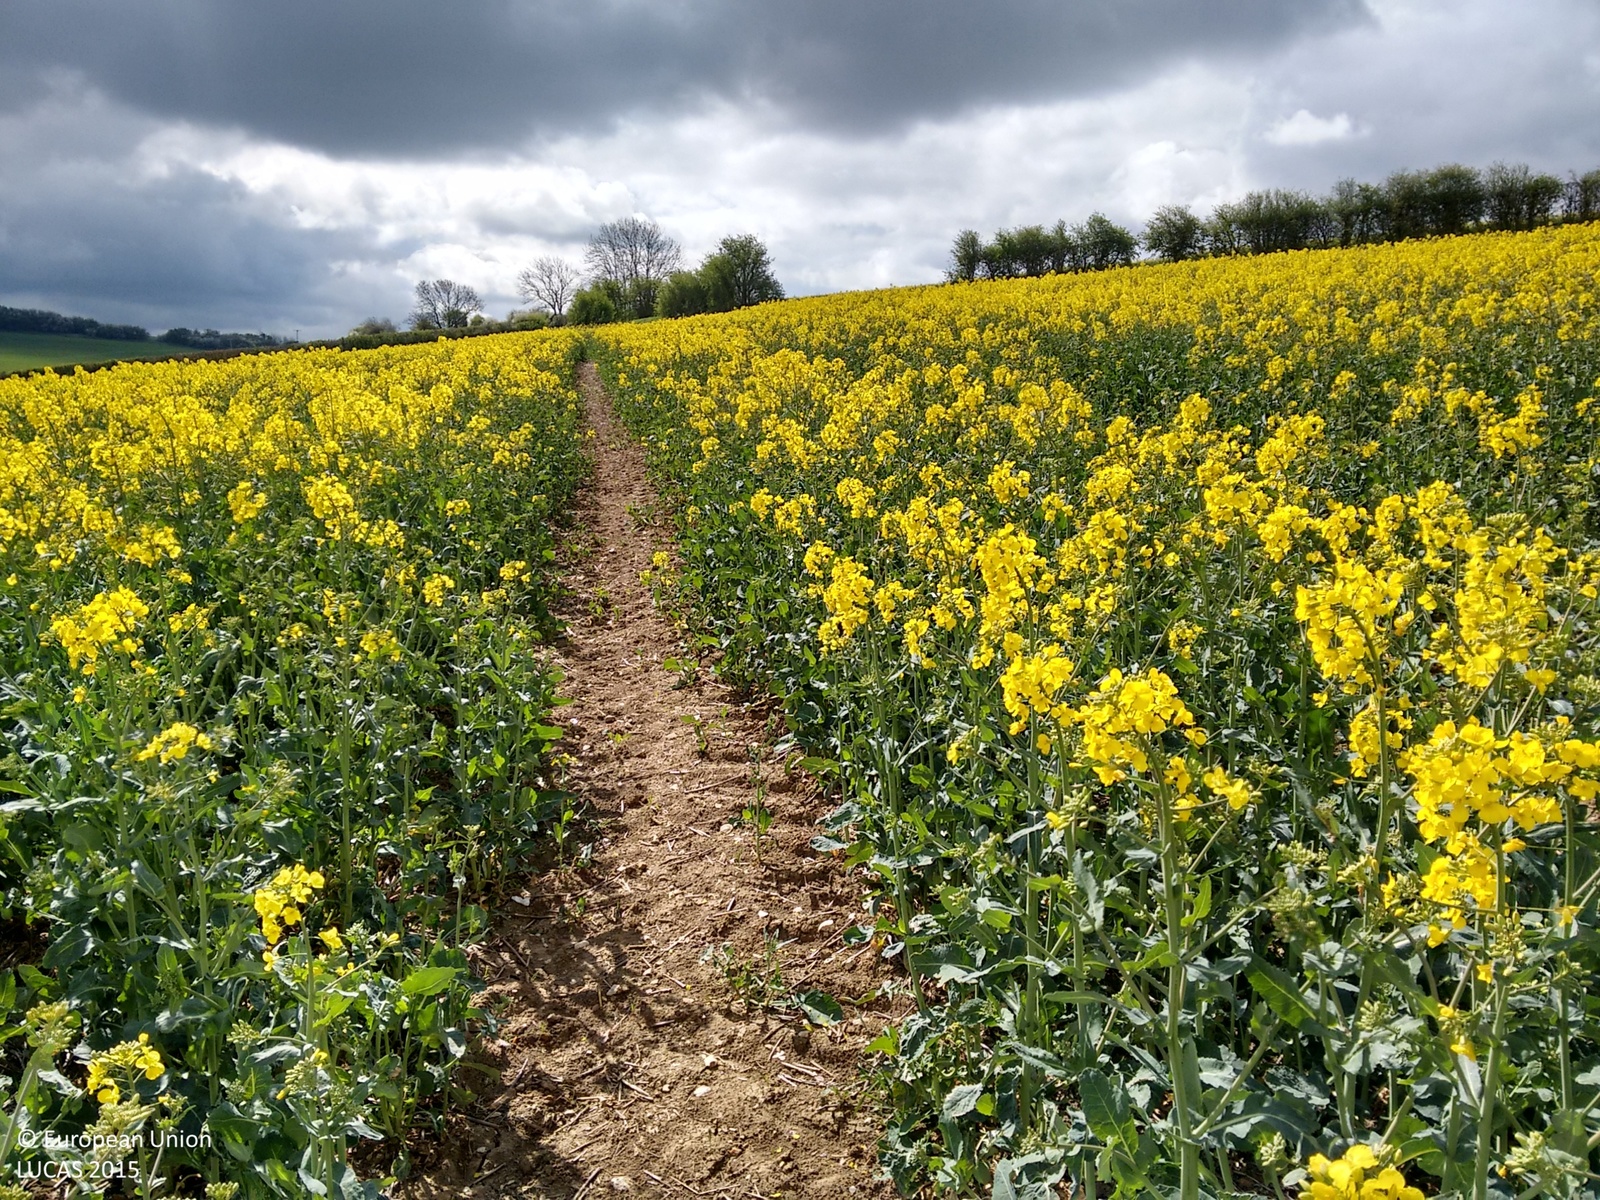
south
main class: Cropland
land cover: Rape and turnip rape
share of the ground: > 75 %
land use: Agriculture (excluding fallow land and kitchen gardens)
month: April
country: GB
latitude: 53.2538
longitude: -0.0600
